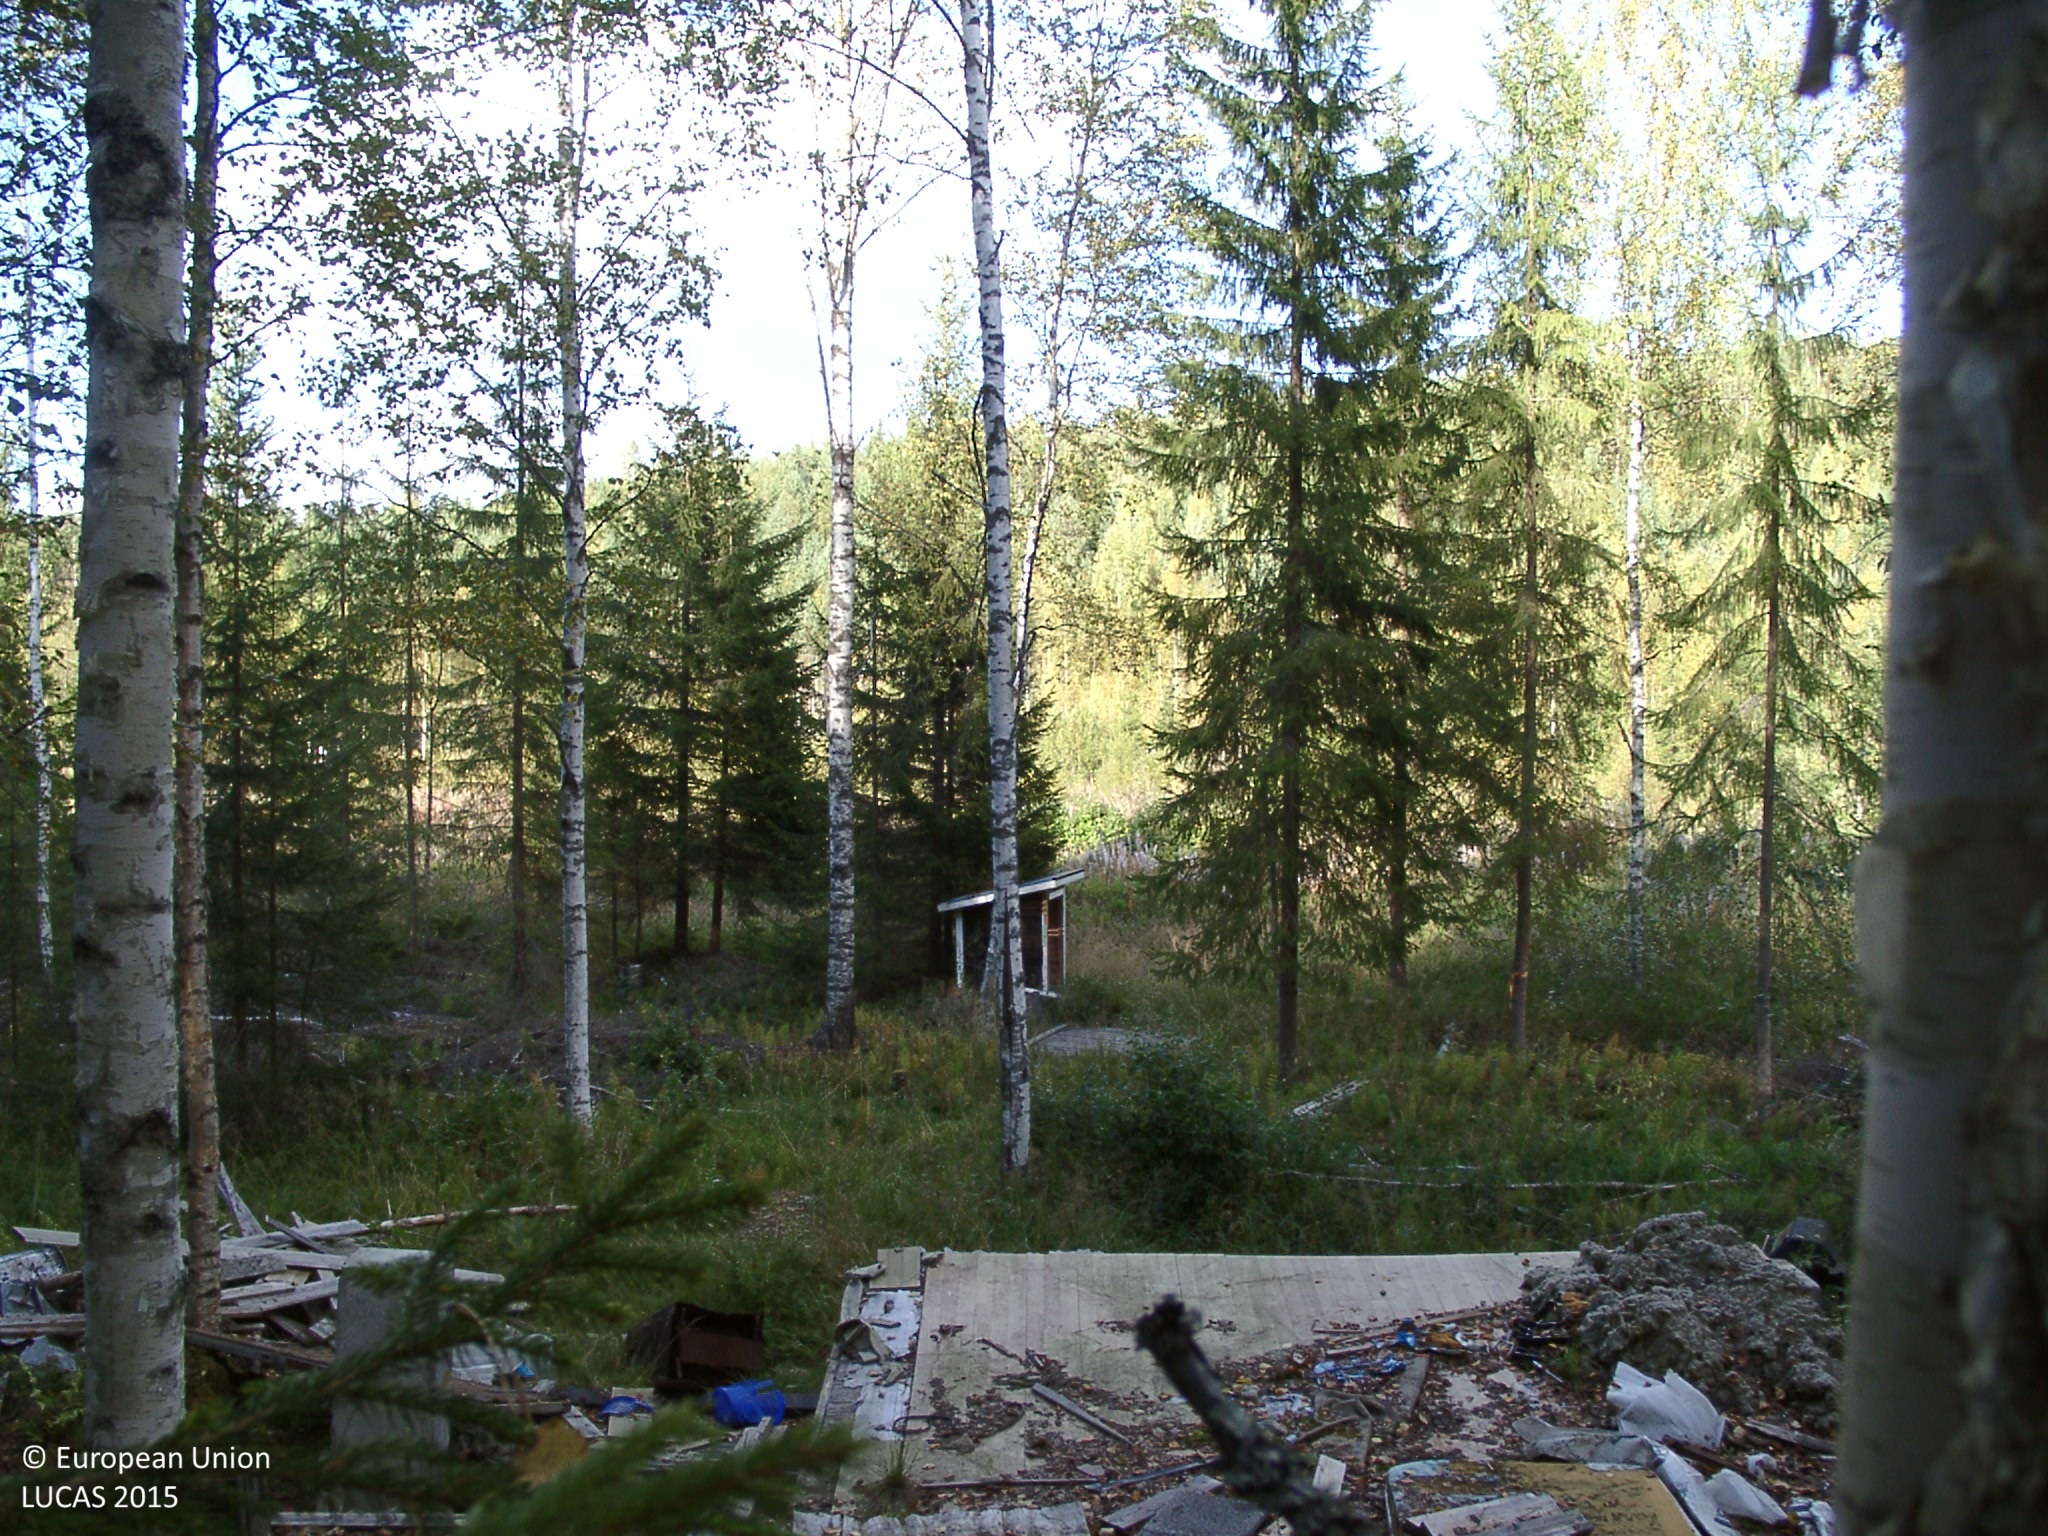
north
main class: Woodland
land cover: Pine dominated mixed woodland
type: boreal forest
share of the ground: 50 - 75 %
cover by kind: coniferous forest trees 30 %, broadleaved forest trees 30 %, herbaceous plants 25 %, lichens and mosses 10 %
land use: Forestry
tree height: > 5 m
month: September
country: FI
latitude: 62.5256
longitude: 25.6388
